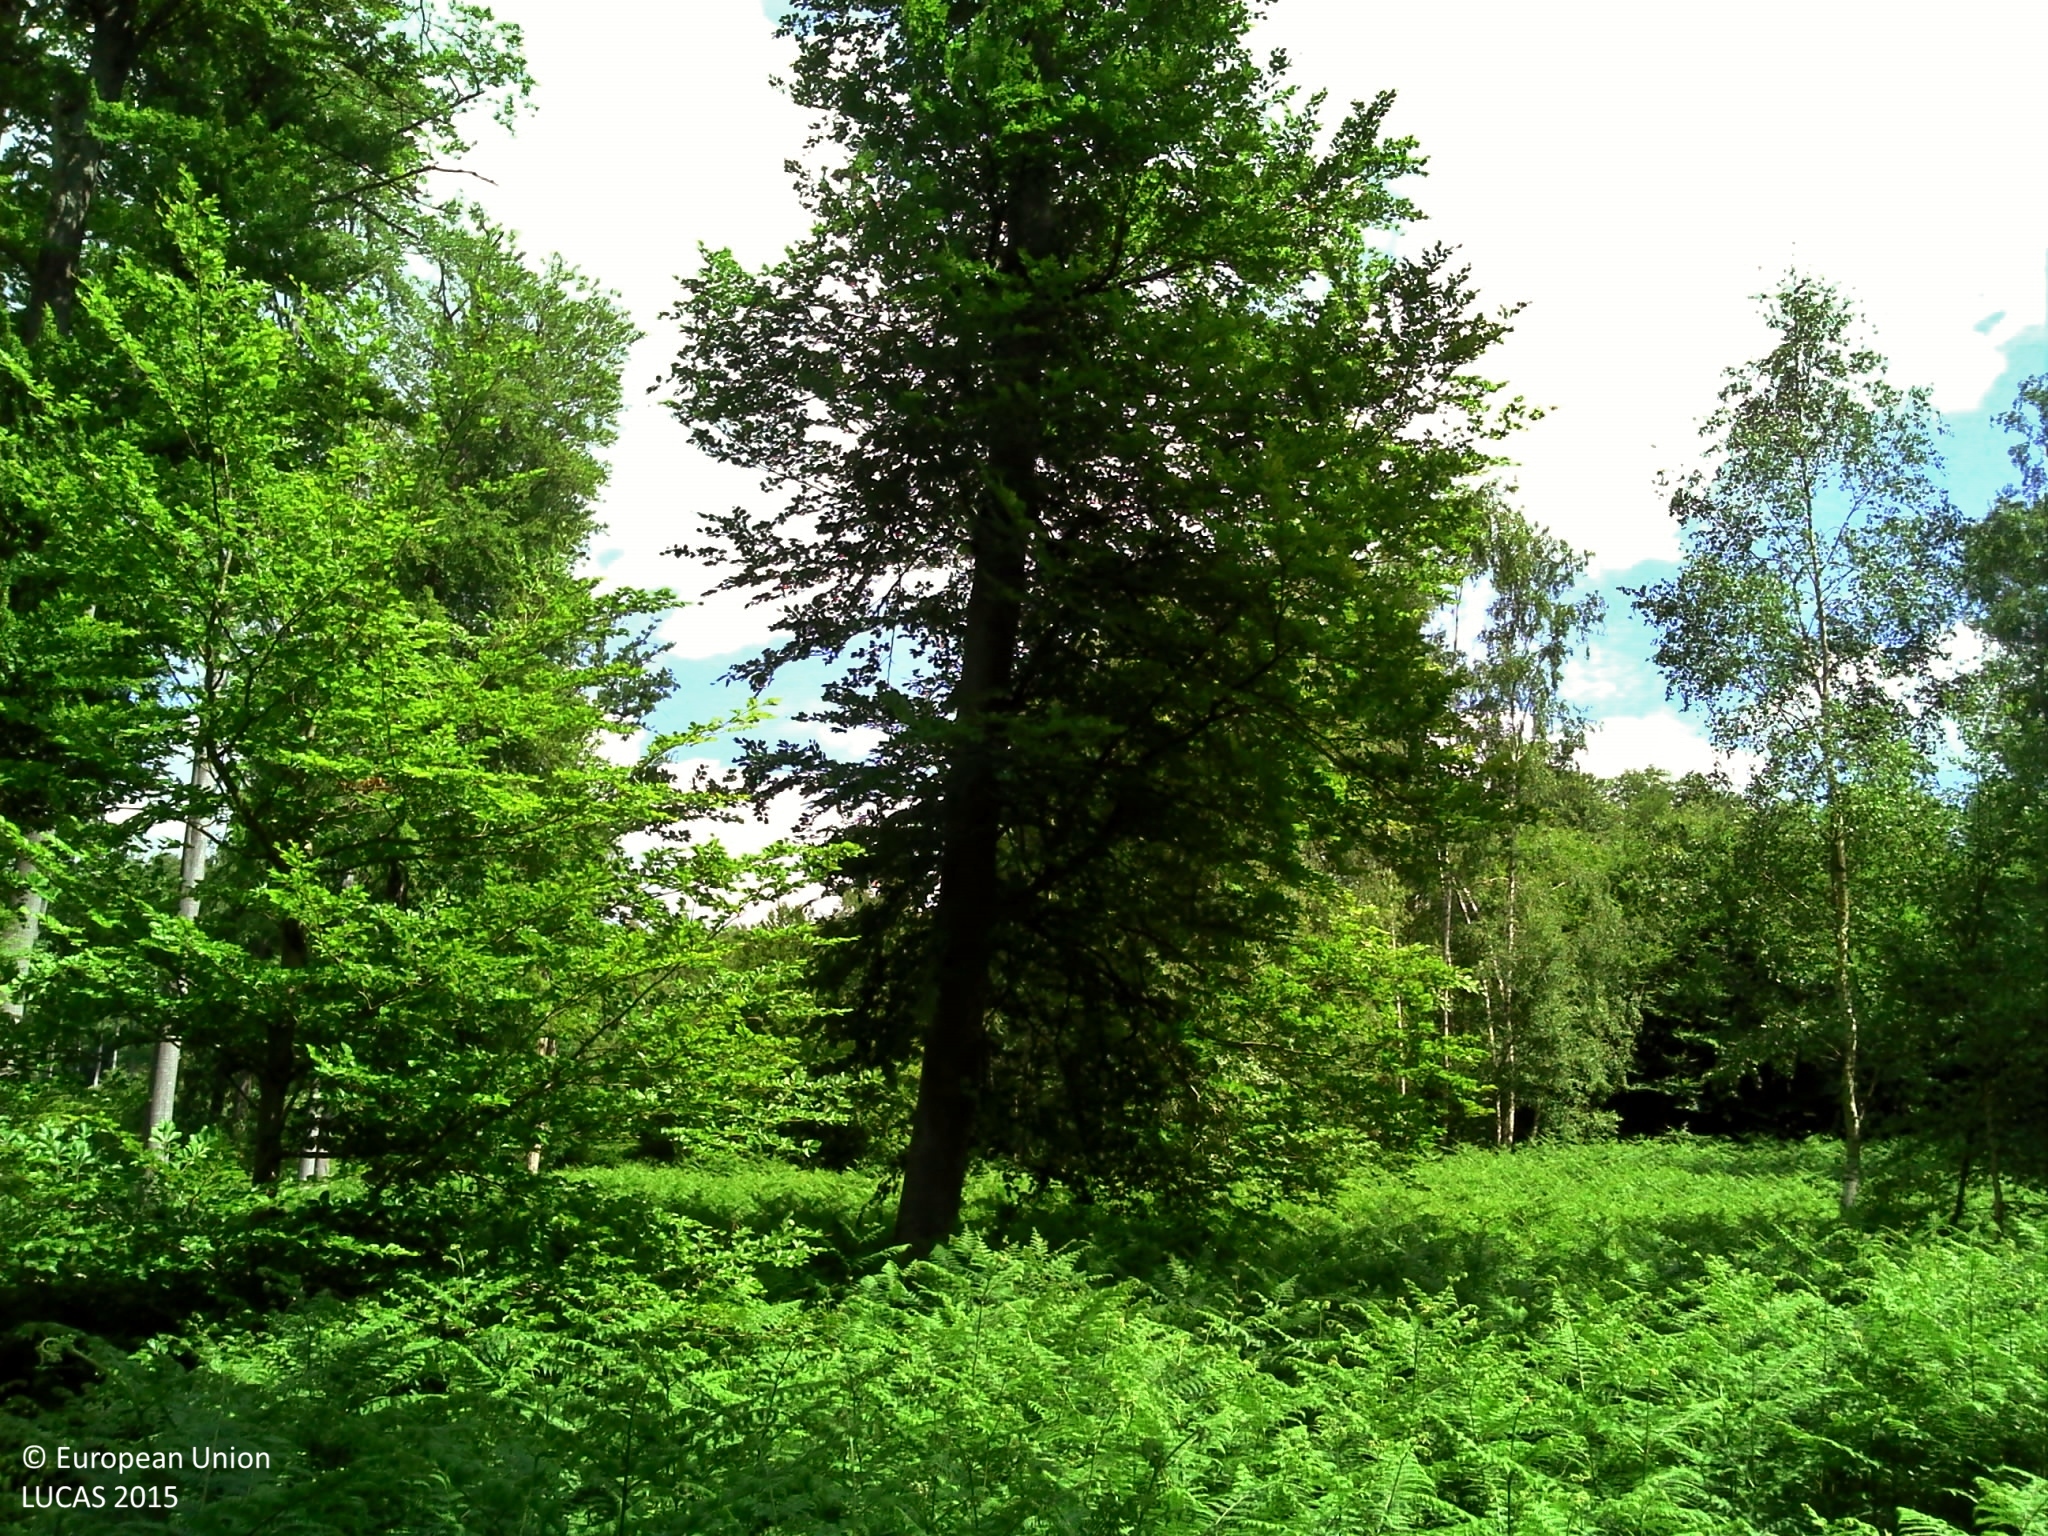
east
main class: Woodland
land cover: Broadleaved woodland
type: beech forest
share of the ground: > 75 %
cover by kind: broadleaved forest trees 75 %, shrubs 15 %, herbaceous plants 5 %, unconsolidated bare surface 5 %
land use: Forestry
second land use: Amenities, museums, leisure
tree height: > 5 m
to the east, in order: Broadleaved woodland; Tracks; Broadleaved woodland
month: June
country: FR
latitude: 49.3508
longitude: 2.9284
